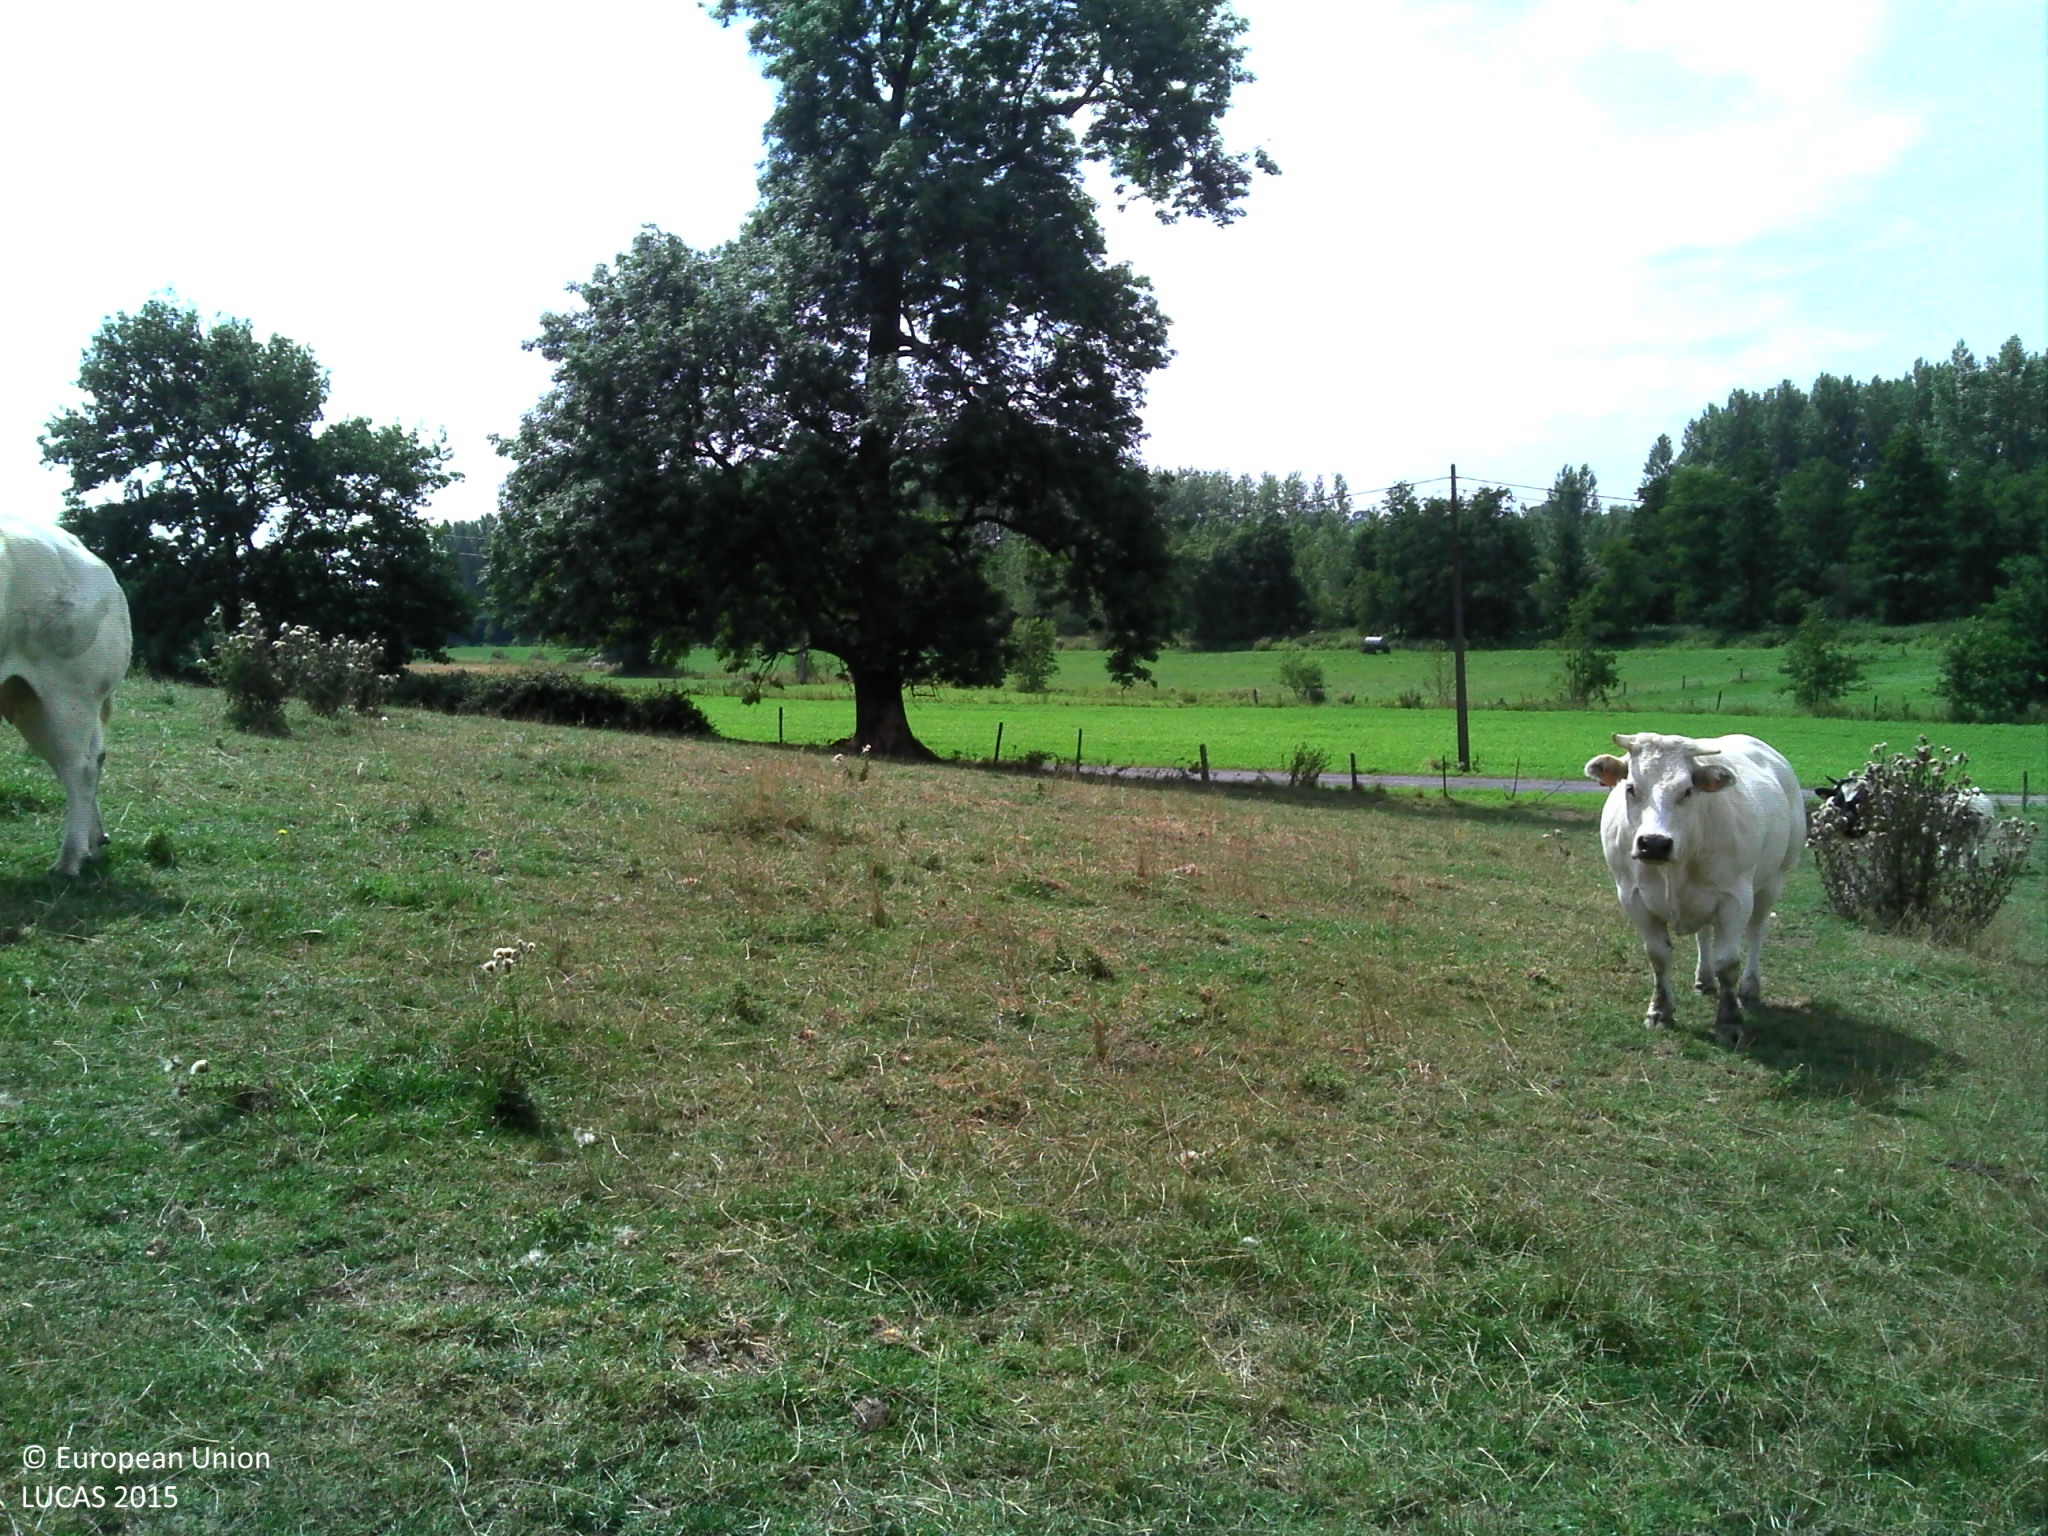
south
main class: Grassland
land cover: Grassland without tree/shrub cover
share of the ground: > 75 %
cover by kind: herbaceous plants 100 %
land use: Agriculture (excluding fallow land and kitchen gardens)
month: August
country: BE
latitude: 50.7354
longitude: 3.7731
